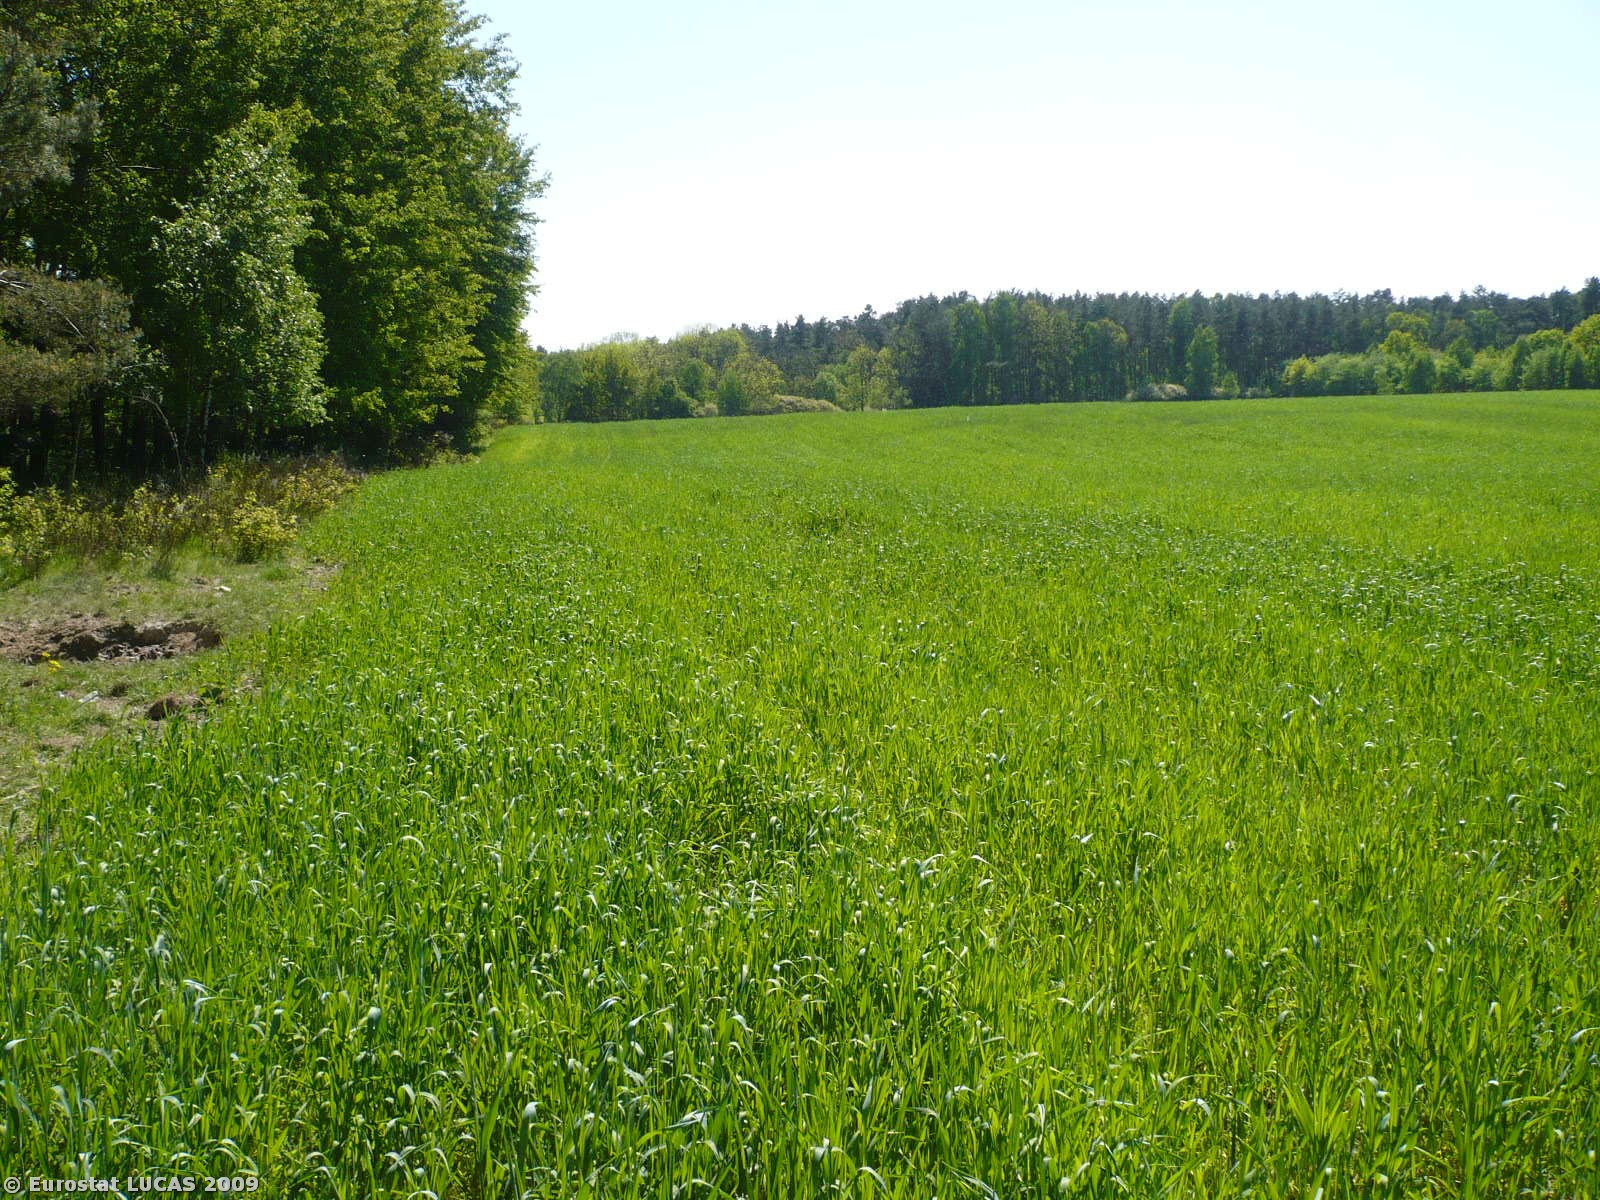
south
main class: Cropland
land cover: Rye
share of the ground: > 75 %
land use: Agriculture (excluding fallow land and kitchen gardens)
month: May
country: PL
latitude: 52.1689
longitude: 15.6922
